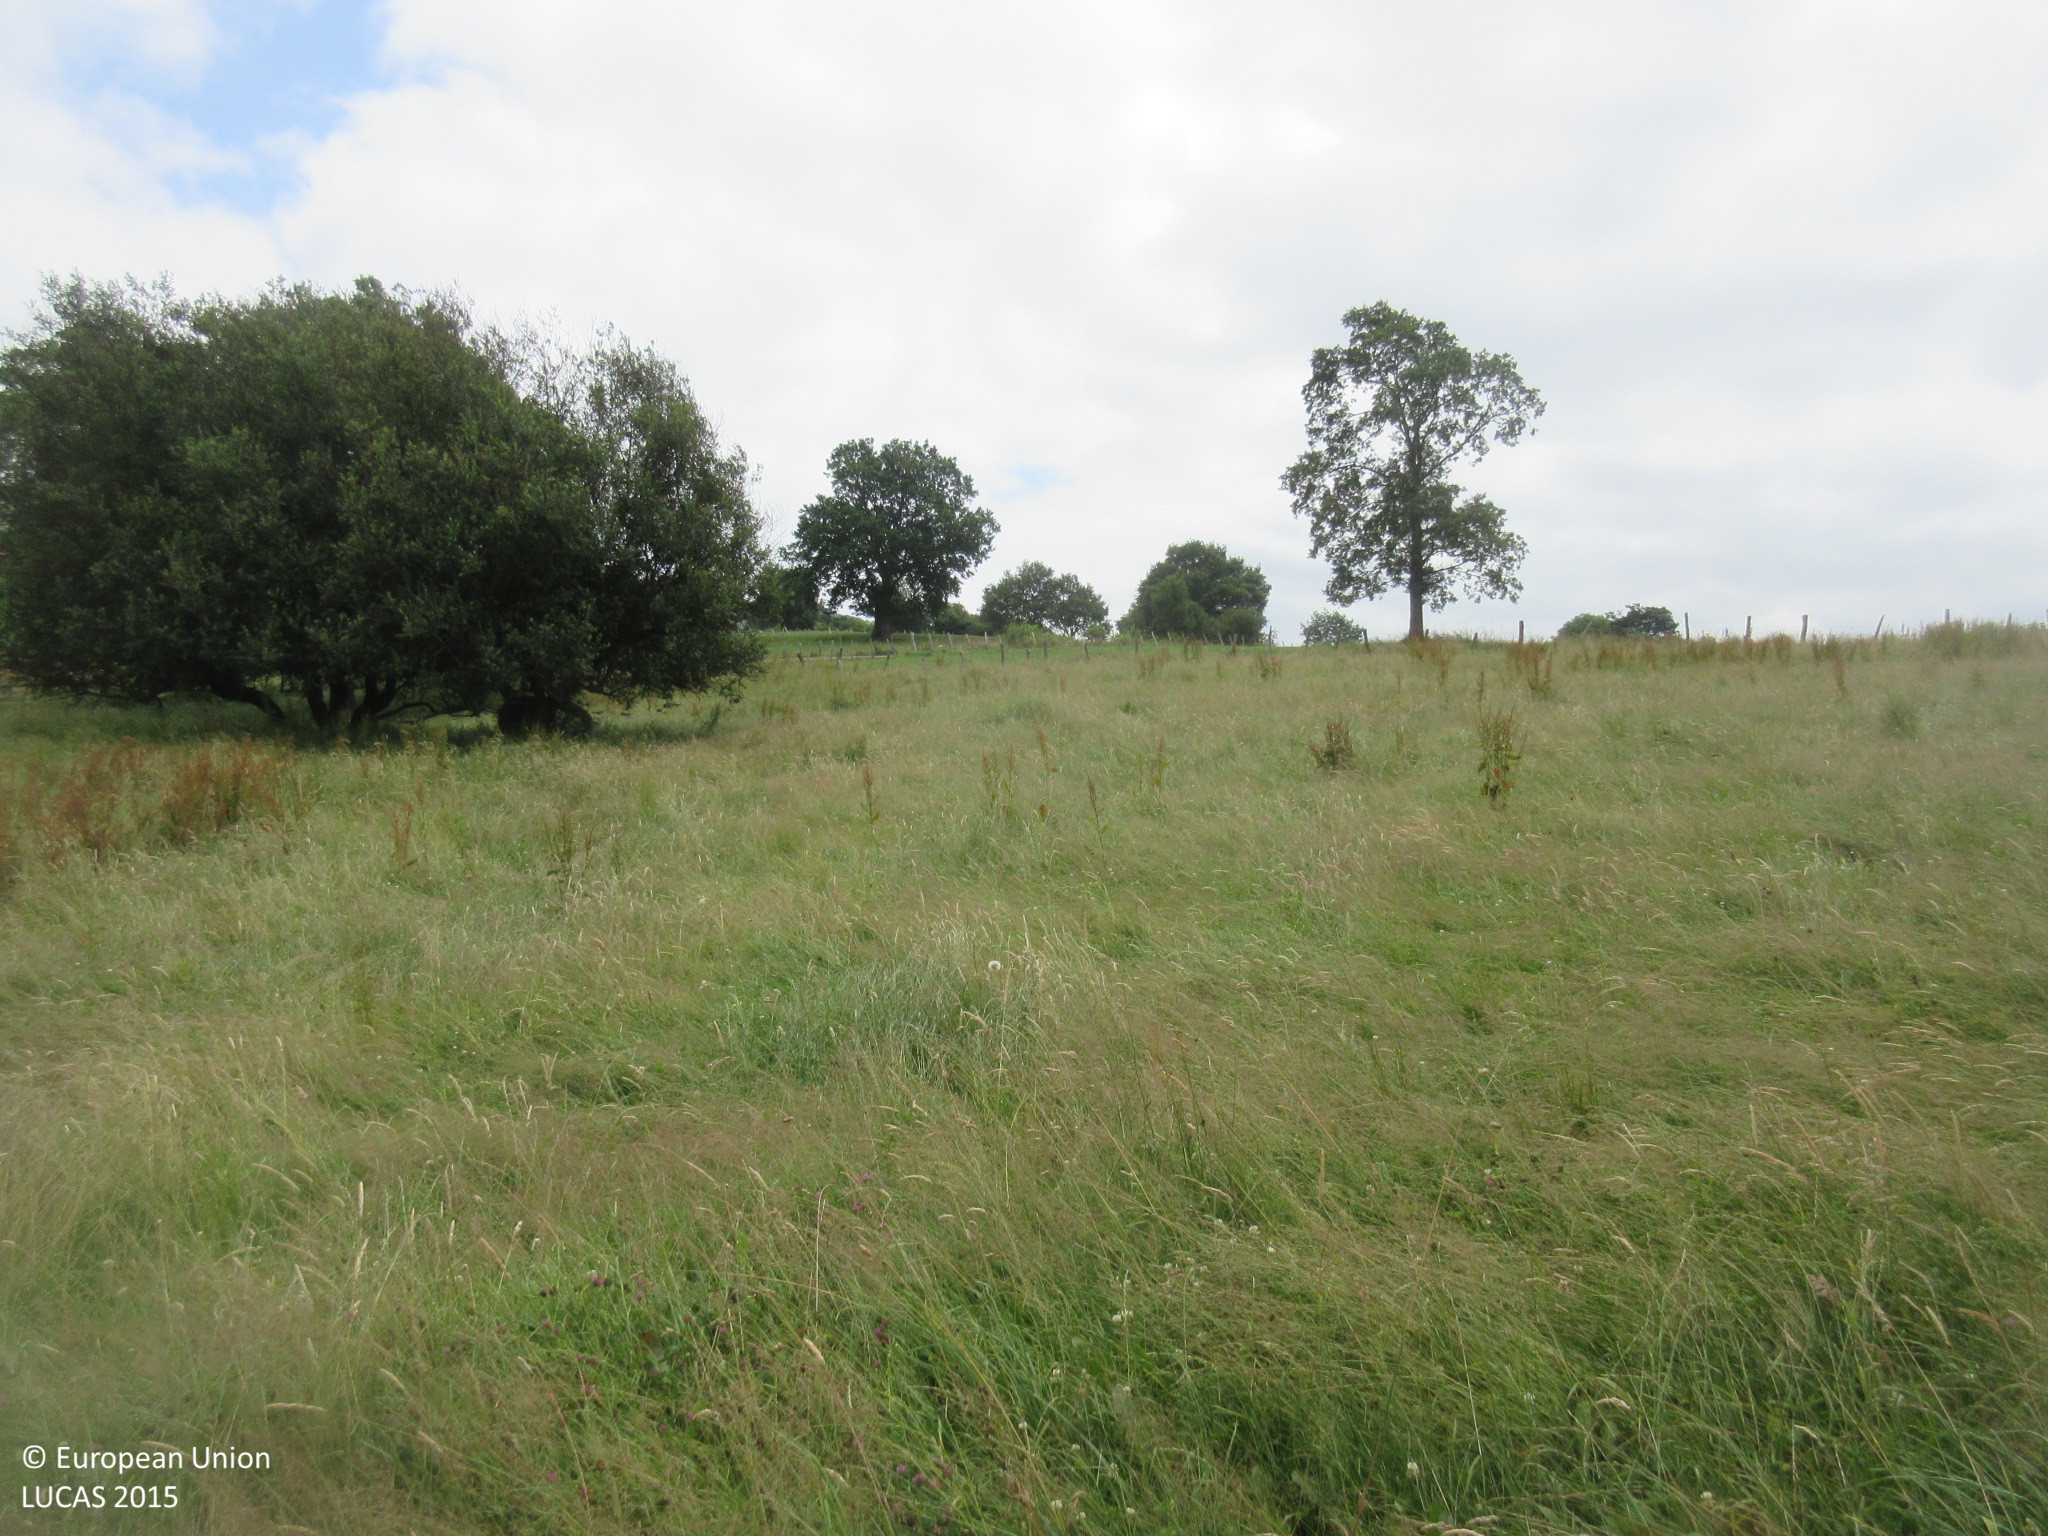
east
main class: Grassland
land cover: Grassland with sparse tree/shrub cover
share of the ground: > 75 %
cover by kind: herbaceous plants 95 %, broadleaved forest trees 5 %
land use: Agriculture (excluding fallow land and kitchen gardens)
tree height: > 5 m
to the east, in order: Grassland with sparse tree/shrub cover; Fences; Grassland without tree/shrub cover; Fences; Grass margins; Tracks; Fences; Grassland with sparse tree/shrub cover; Dry stone walls; Paved roads, cycling and walking lanes; Abandoned hedges; Groves; Grassland without tree/shrub cover; Dry stone walls; Groves; Grassland without tree/shrub cover
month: July
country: ES
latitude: 43.1989
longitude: -3.5677
